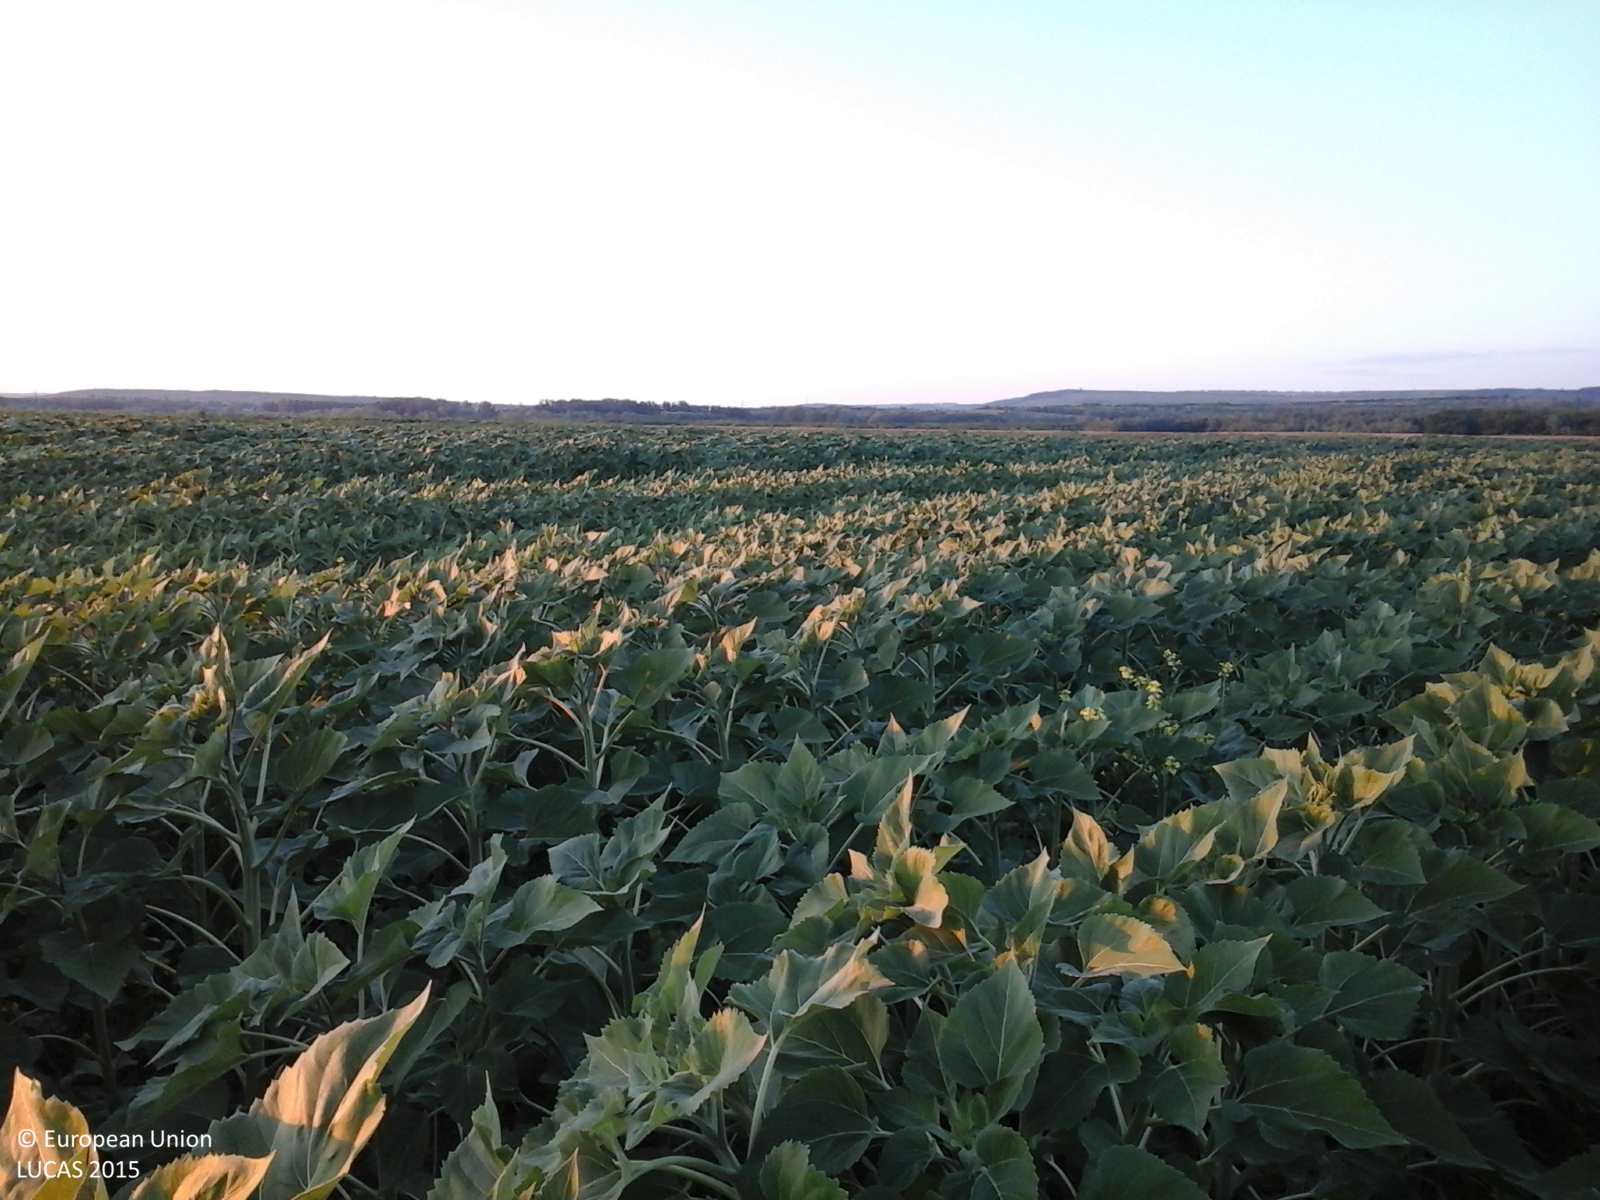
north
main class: Cropland
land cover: Sunflower
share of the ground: 50 - 75 %
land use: Agriculture (excluding fallow land and kitchen gardens)
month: June
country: RO
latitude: 46.9707
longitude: 28.0742
